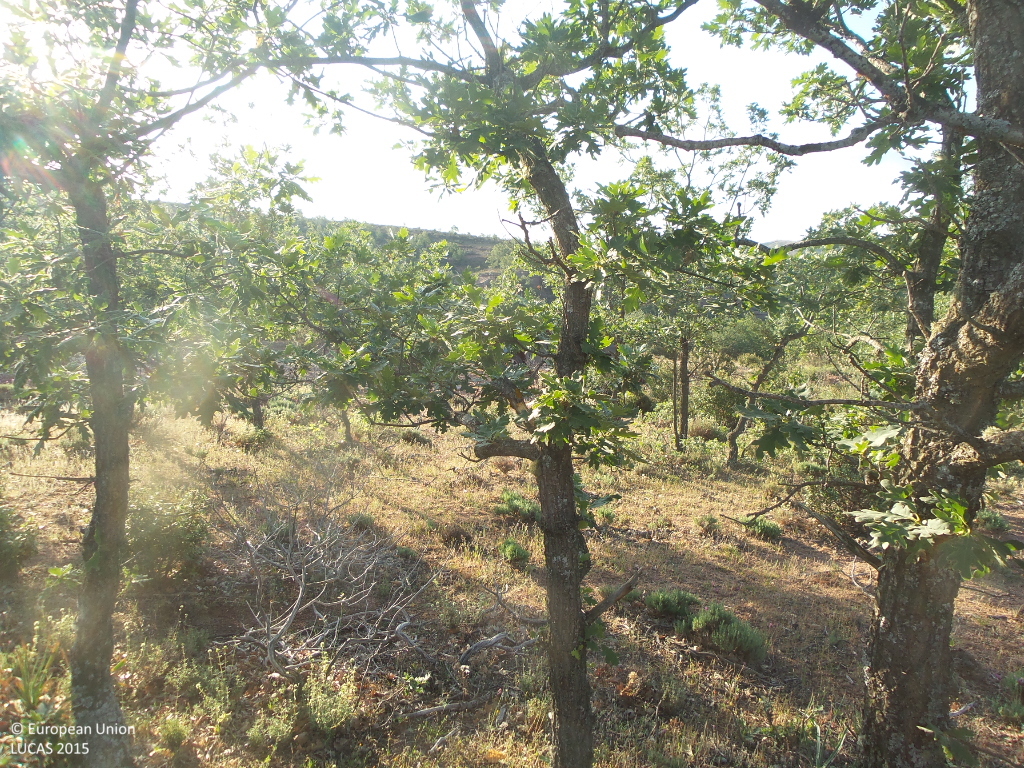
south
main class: Woodland
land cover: Broadleaved woodland
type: thermophilous deciduous forest
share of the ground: 50 - 75 %
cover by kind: broadleaved forest trees 50 %, shrubs 15 %, herbaceous plants 15 %, unconsolidated bare surface 15 %, lichens and mosses 5 %
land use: Semi-natural and natural areas not in use
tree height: < 5 m
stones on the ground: < 10 %
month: June
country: ES
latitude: 41.3032
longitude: -3.1188
